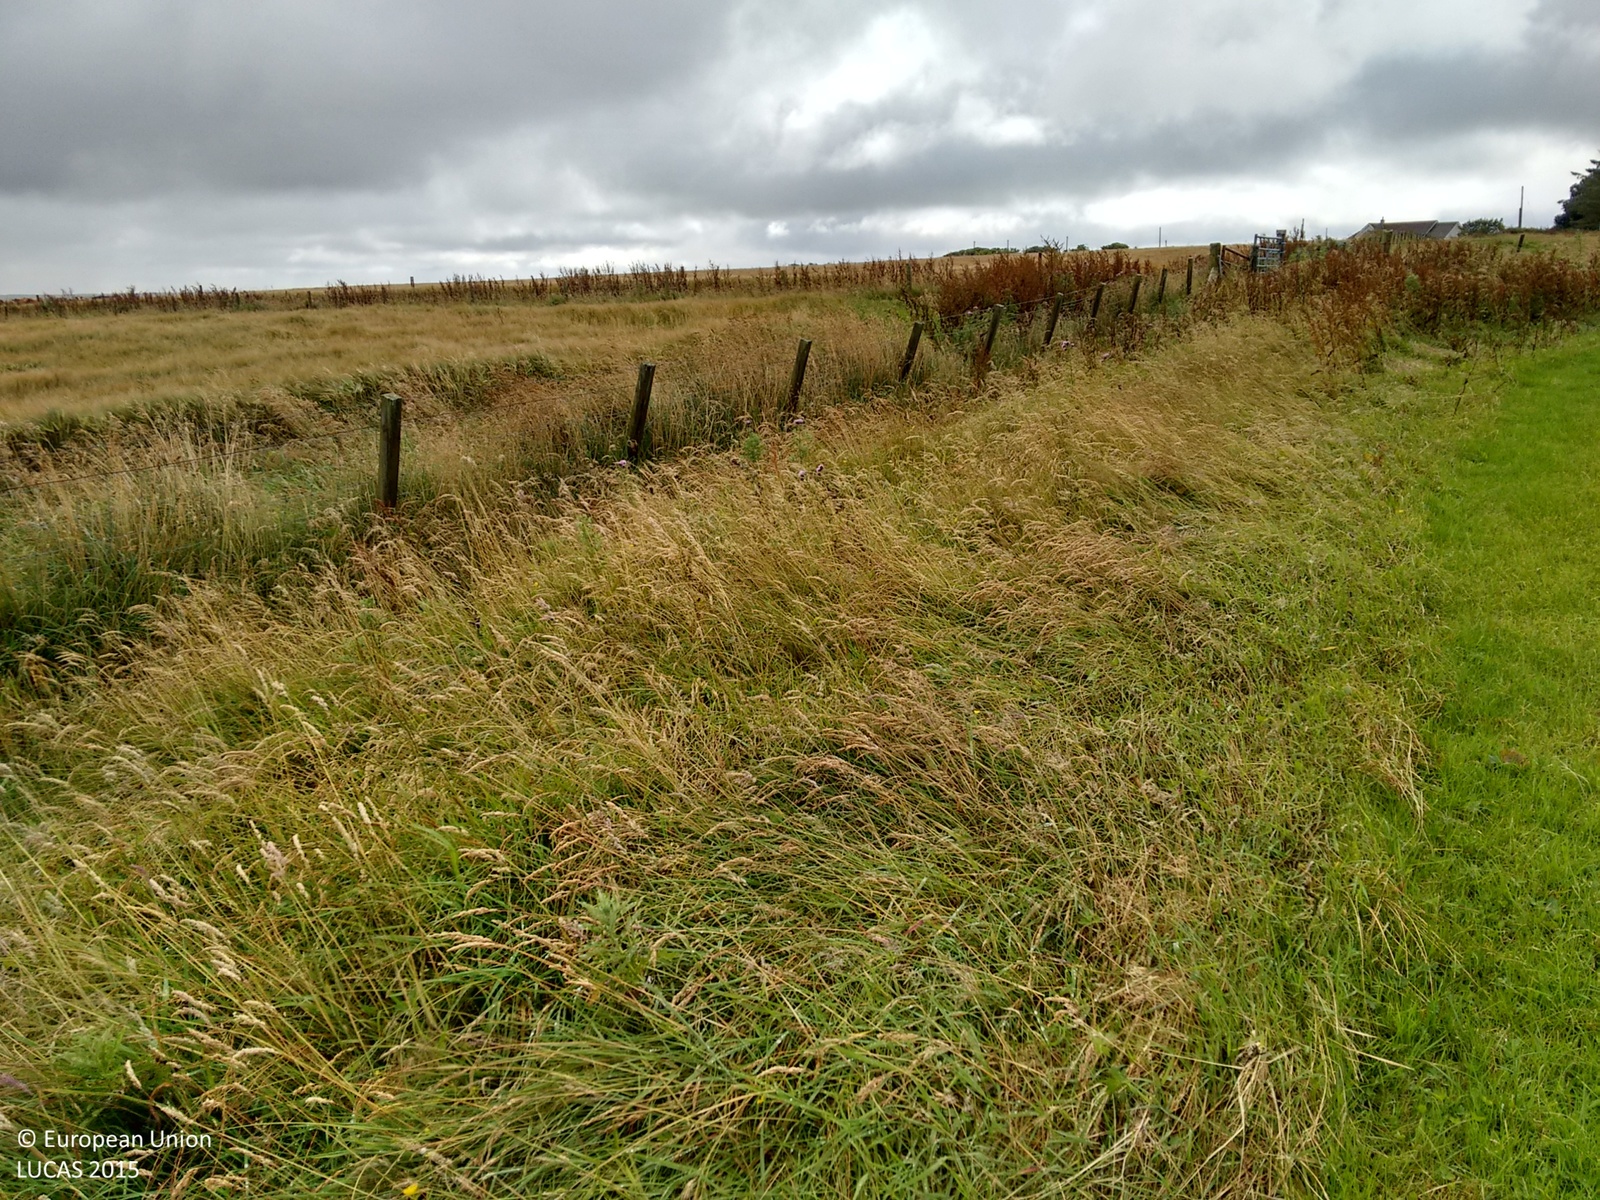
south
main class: Grassland
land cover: Grassland without tree/shrub cover
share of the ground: > 75 %
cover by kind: herbaceous plants 100 %
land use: Agriculture (excluding fallow land and kitchen gardens)
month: August
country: GB
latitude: 58.5121
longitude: -3.2252
